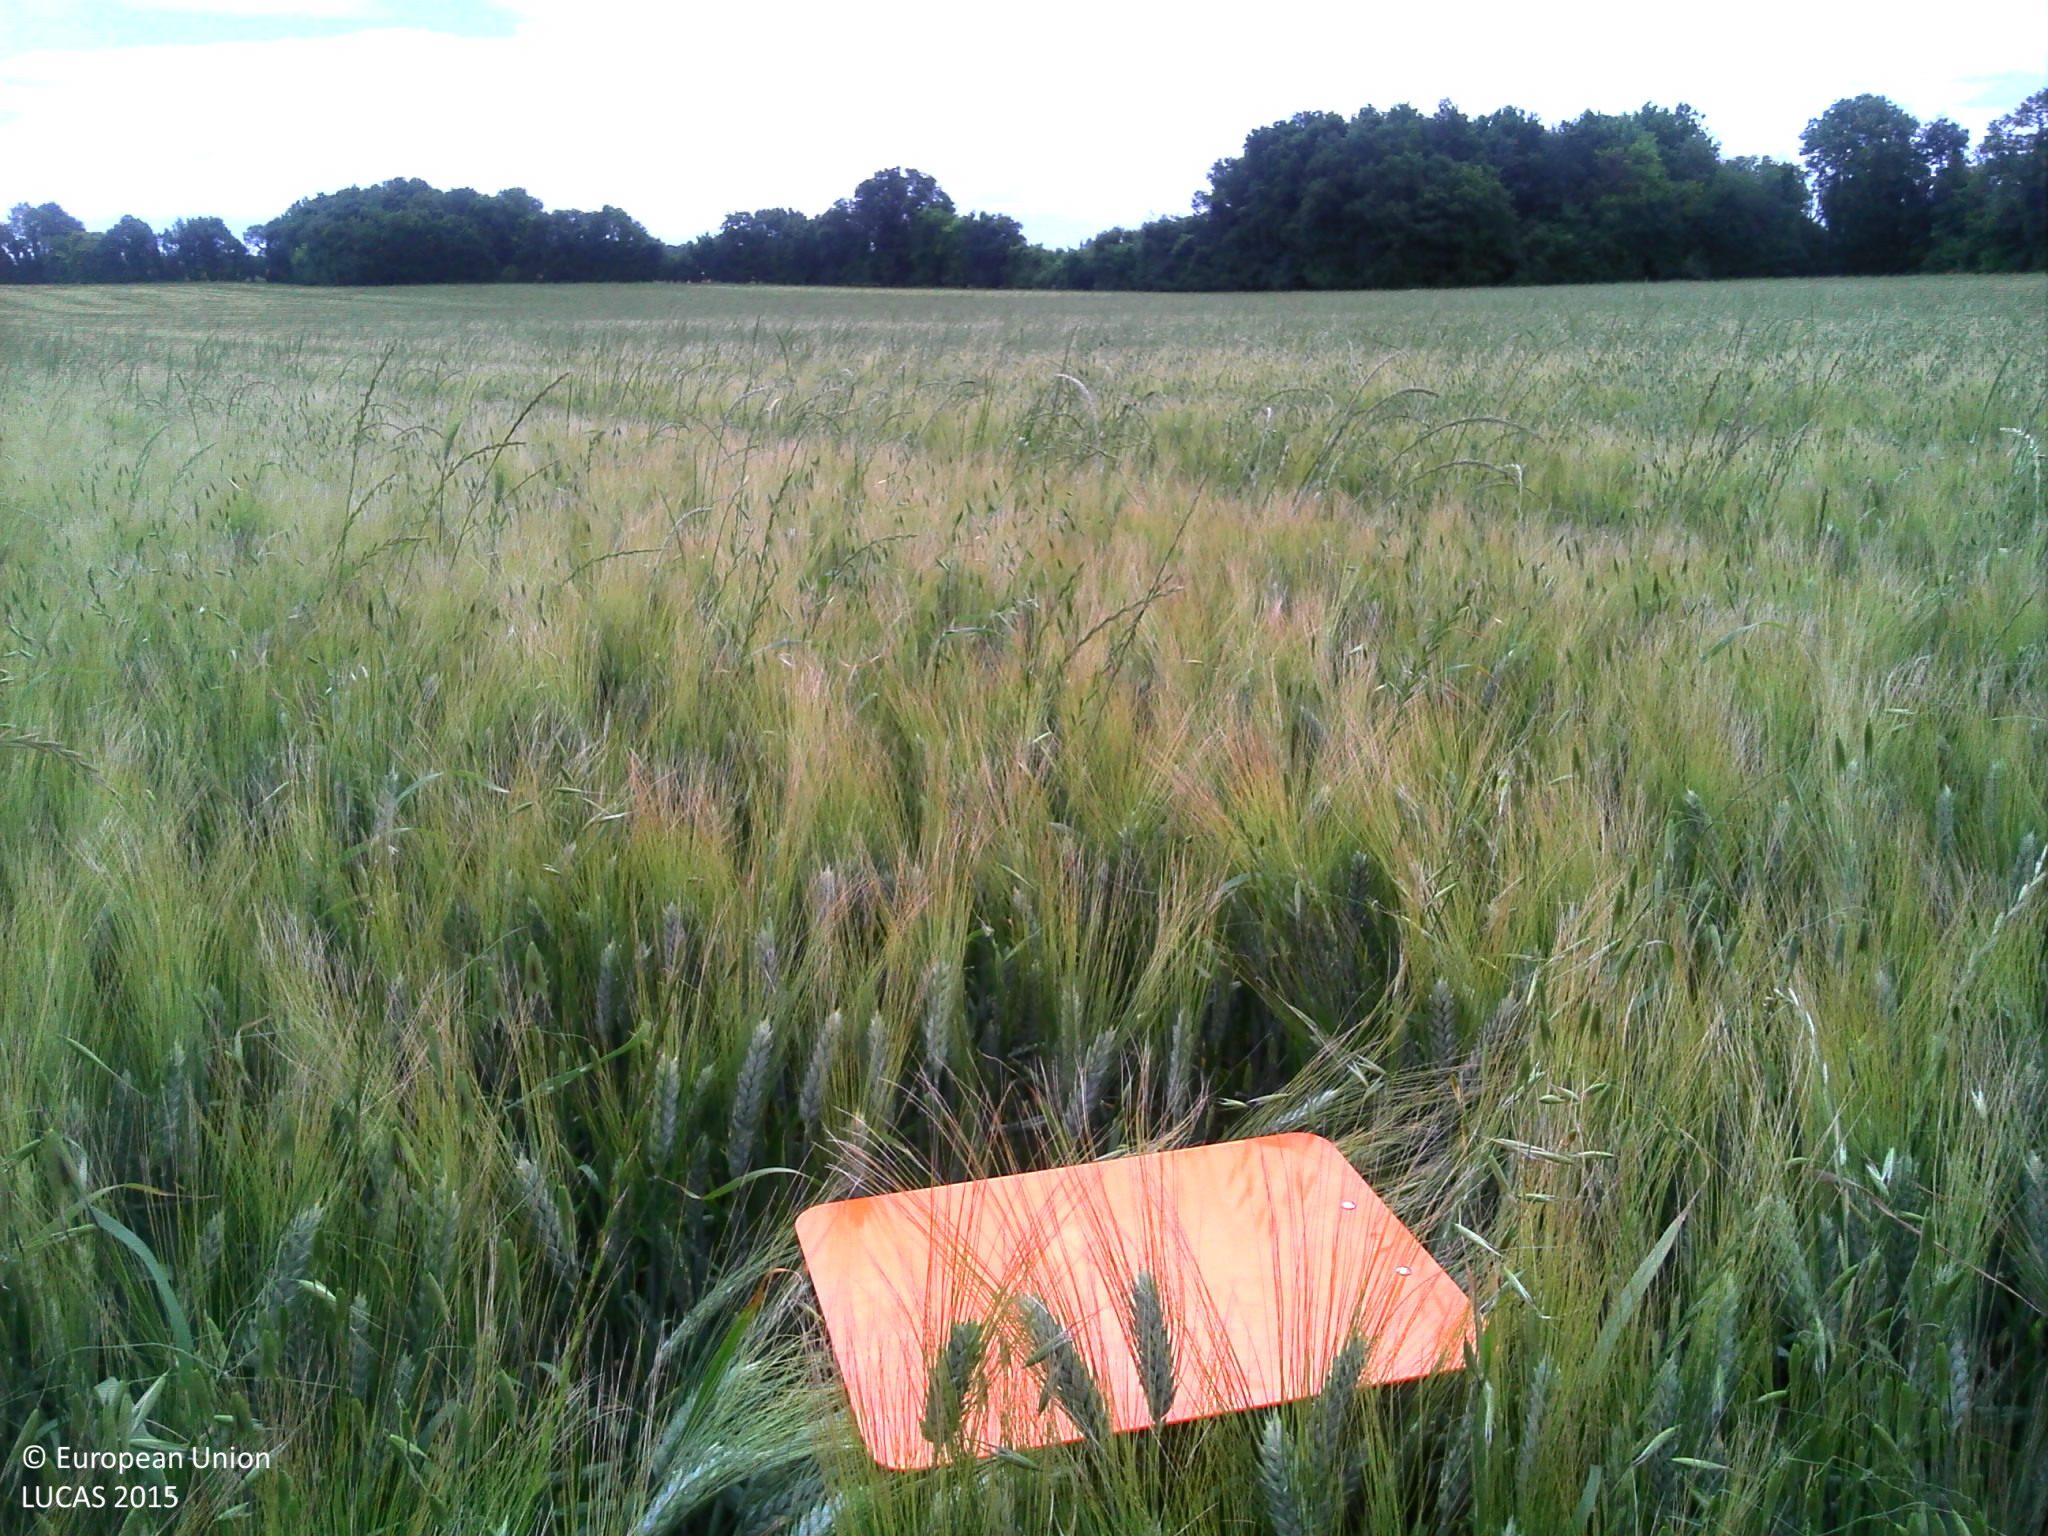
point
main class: Cropland
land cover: Durum wheat
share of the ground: > 75 %
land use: Agriculture (excluding fallow land and kitchen gardens)
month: June
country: FR
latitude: 46.1334
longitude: -0.9408
